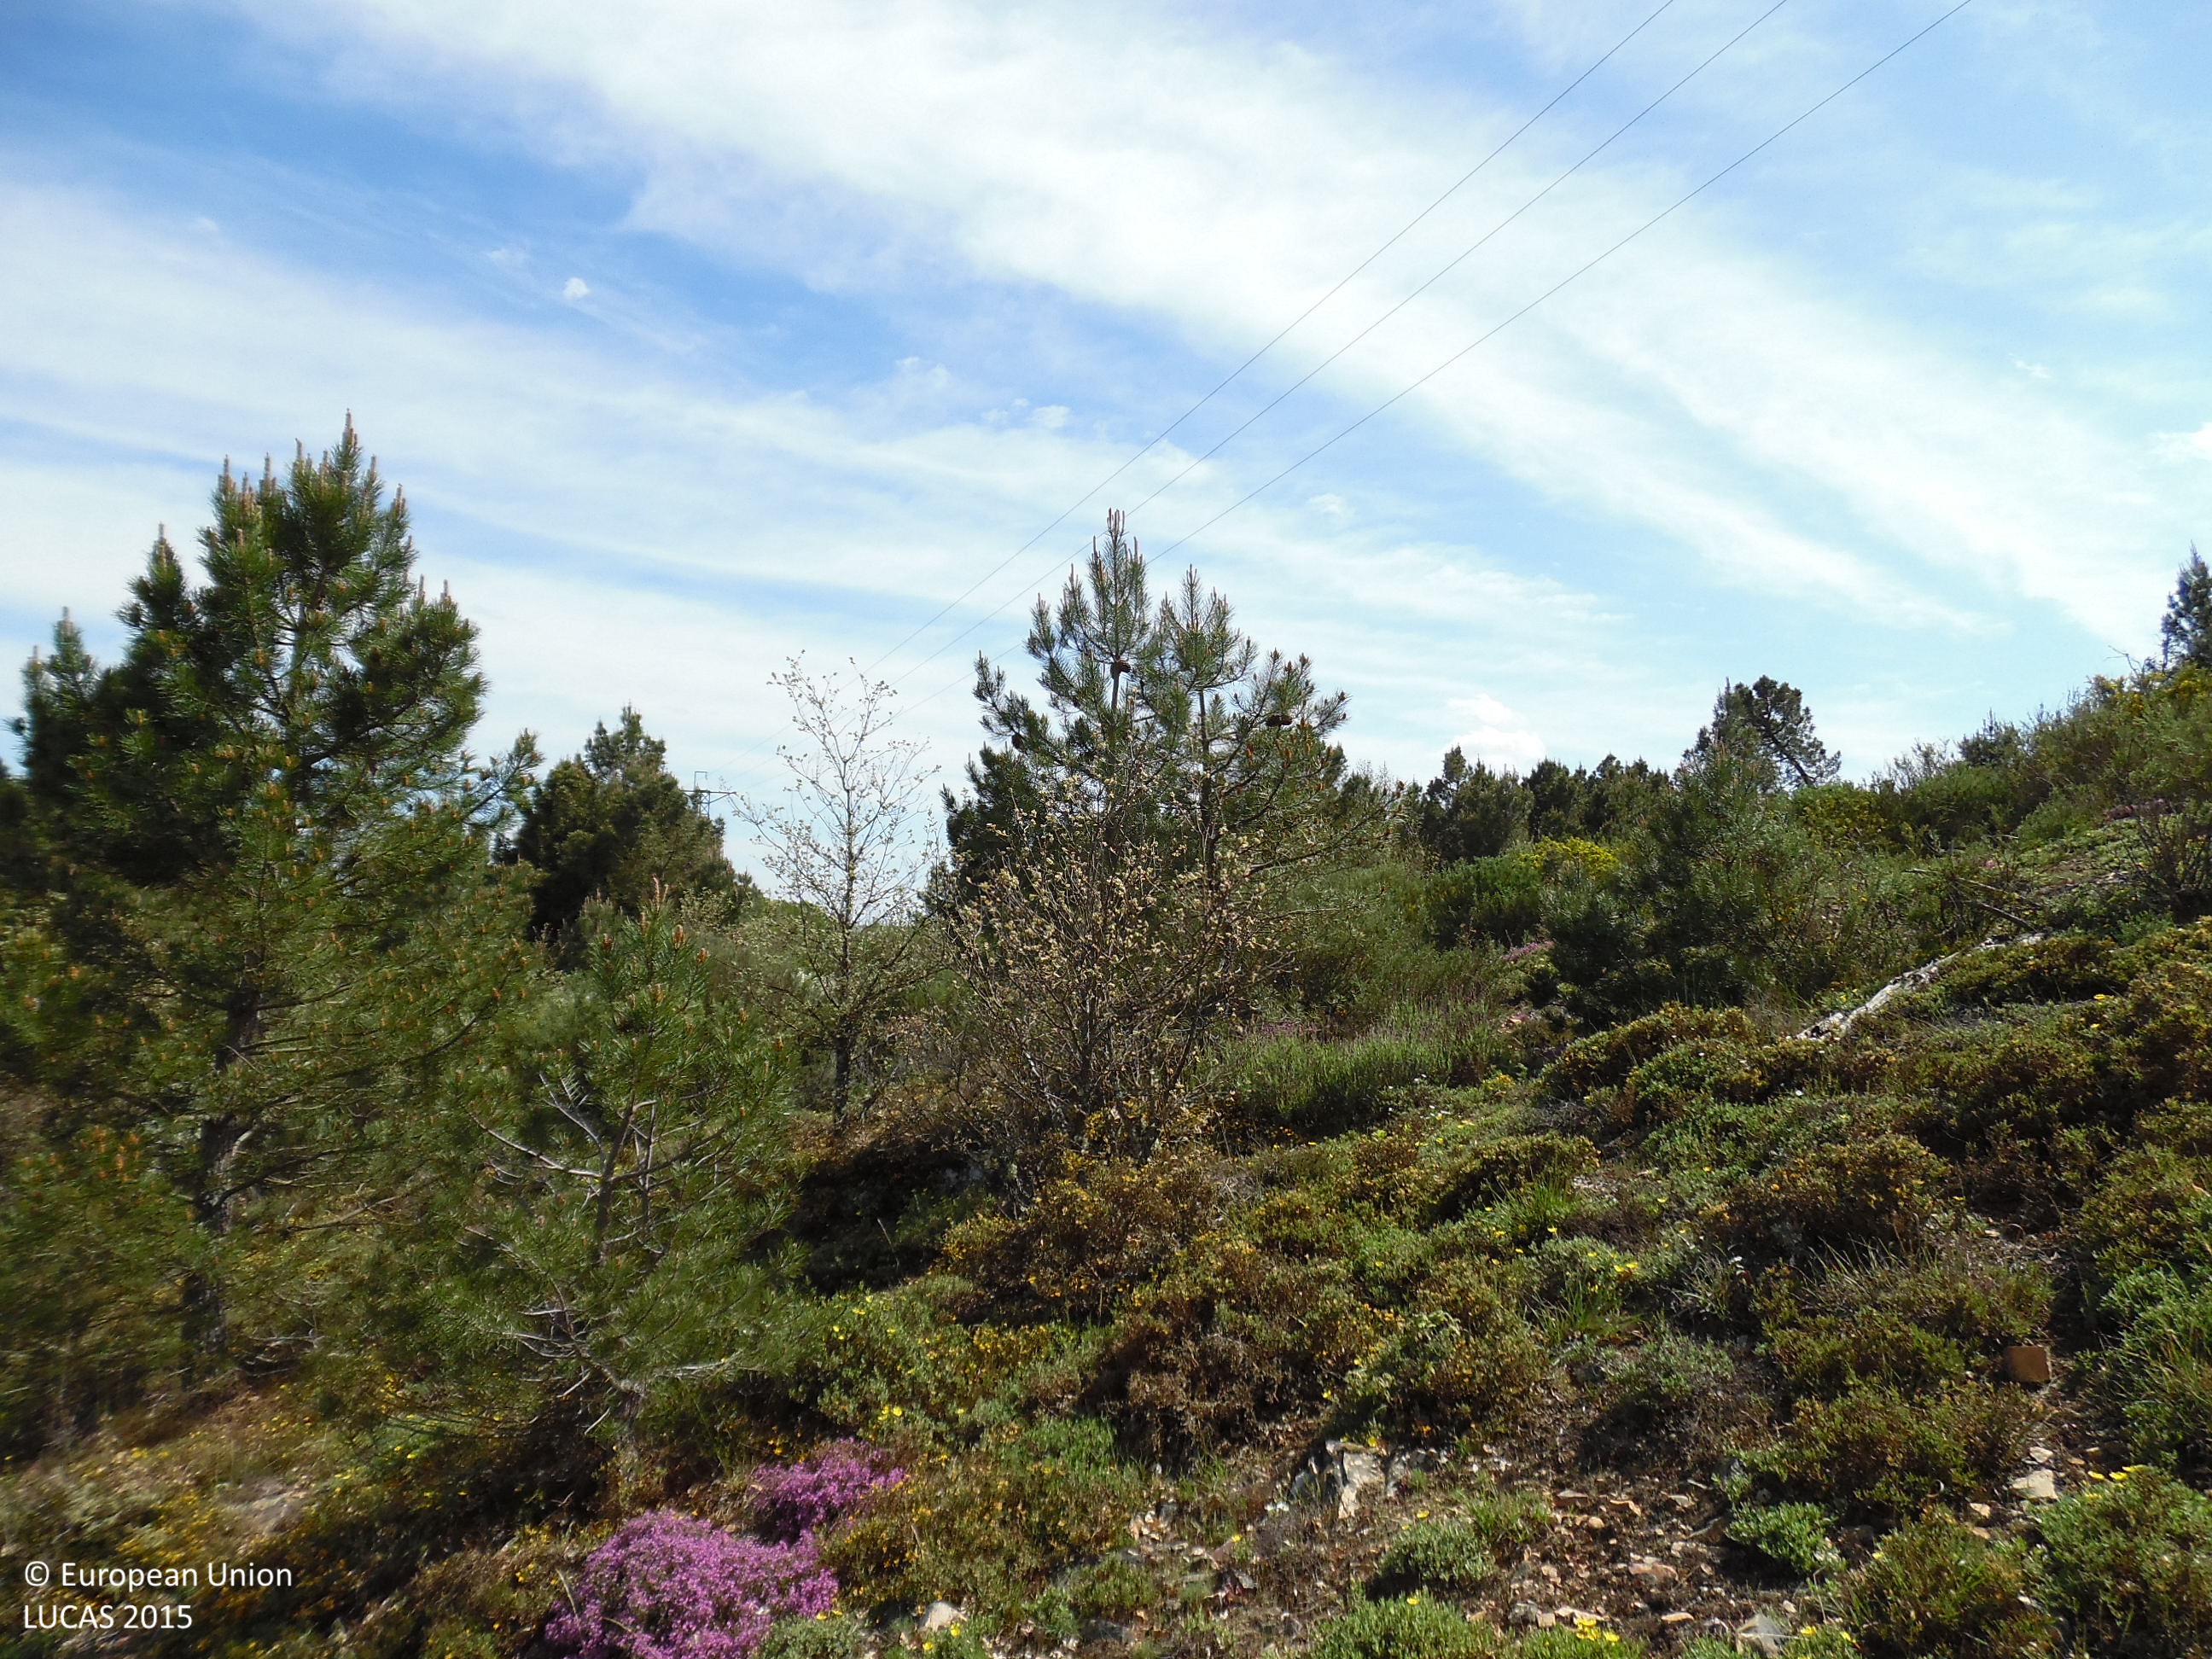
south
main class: Shrubland
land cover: Shrubland with sparse tree cover
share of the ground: > 75 %
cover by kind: shrubs 95 %, broadleaved forest trees 5 %
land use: Forestry
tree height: < 5 m
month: May
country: ES
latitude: 42.5724
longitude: -6.0792
